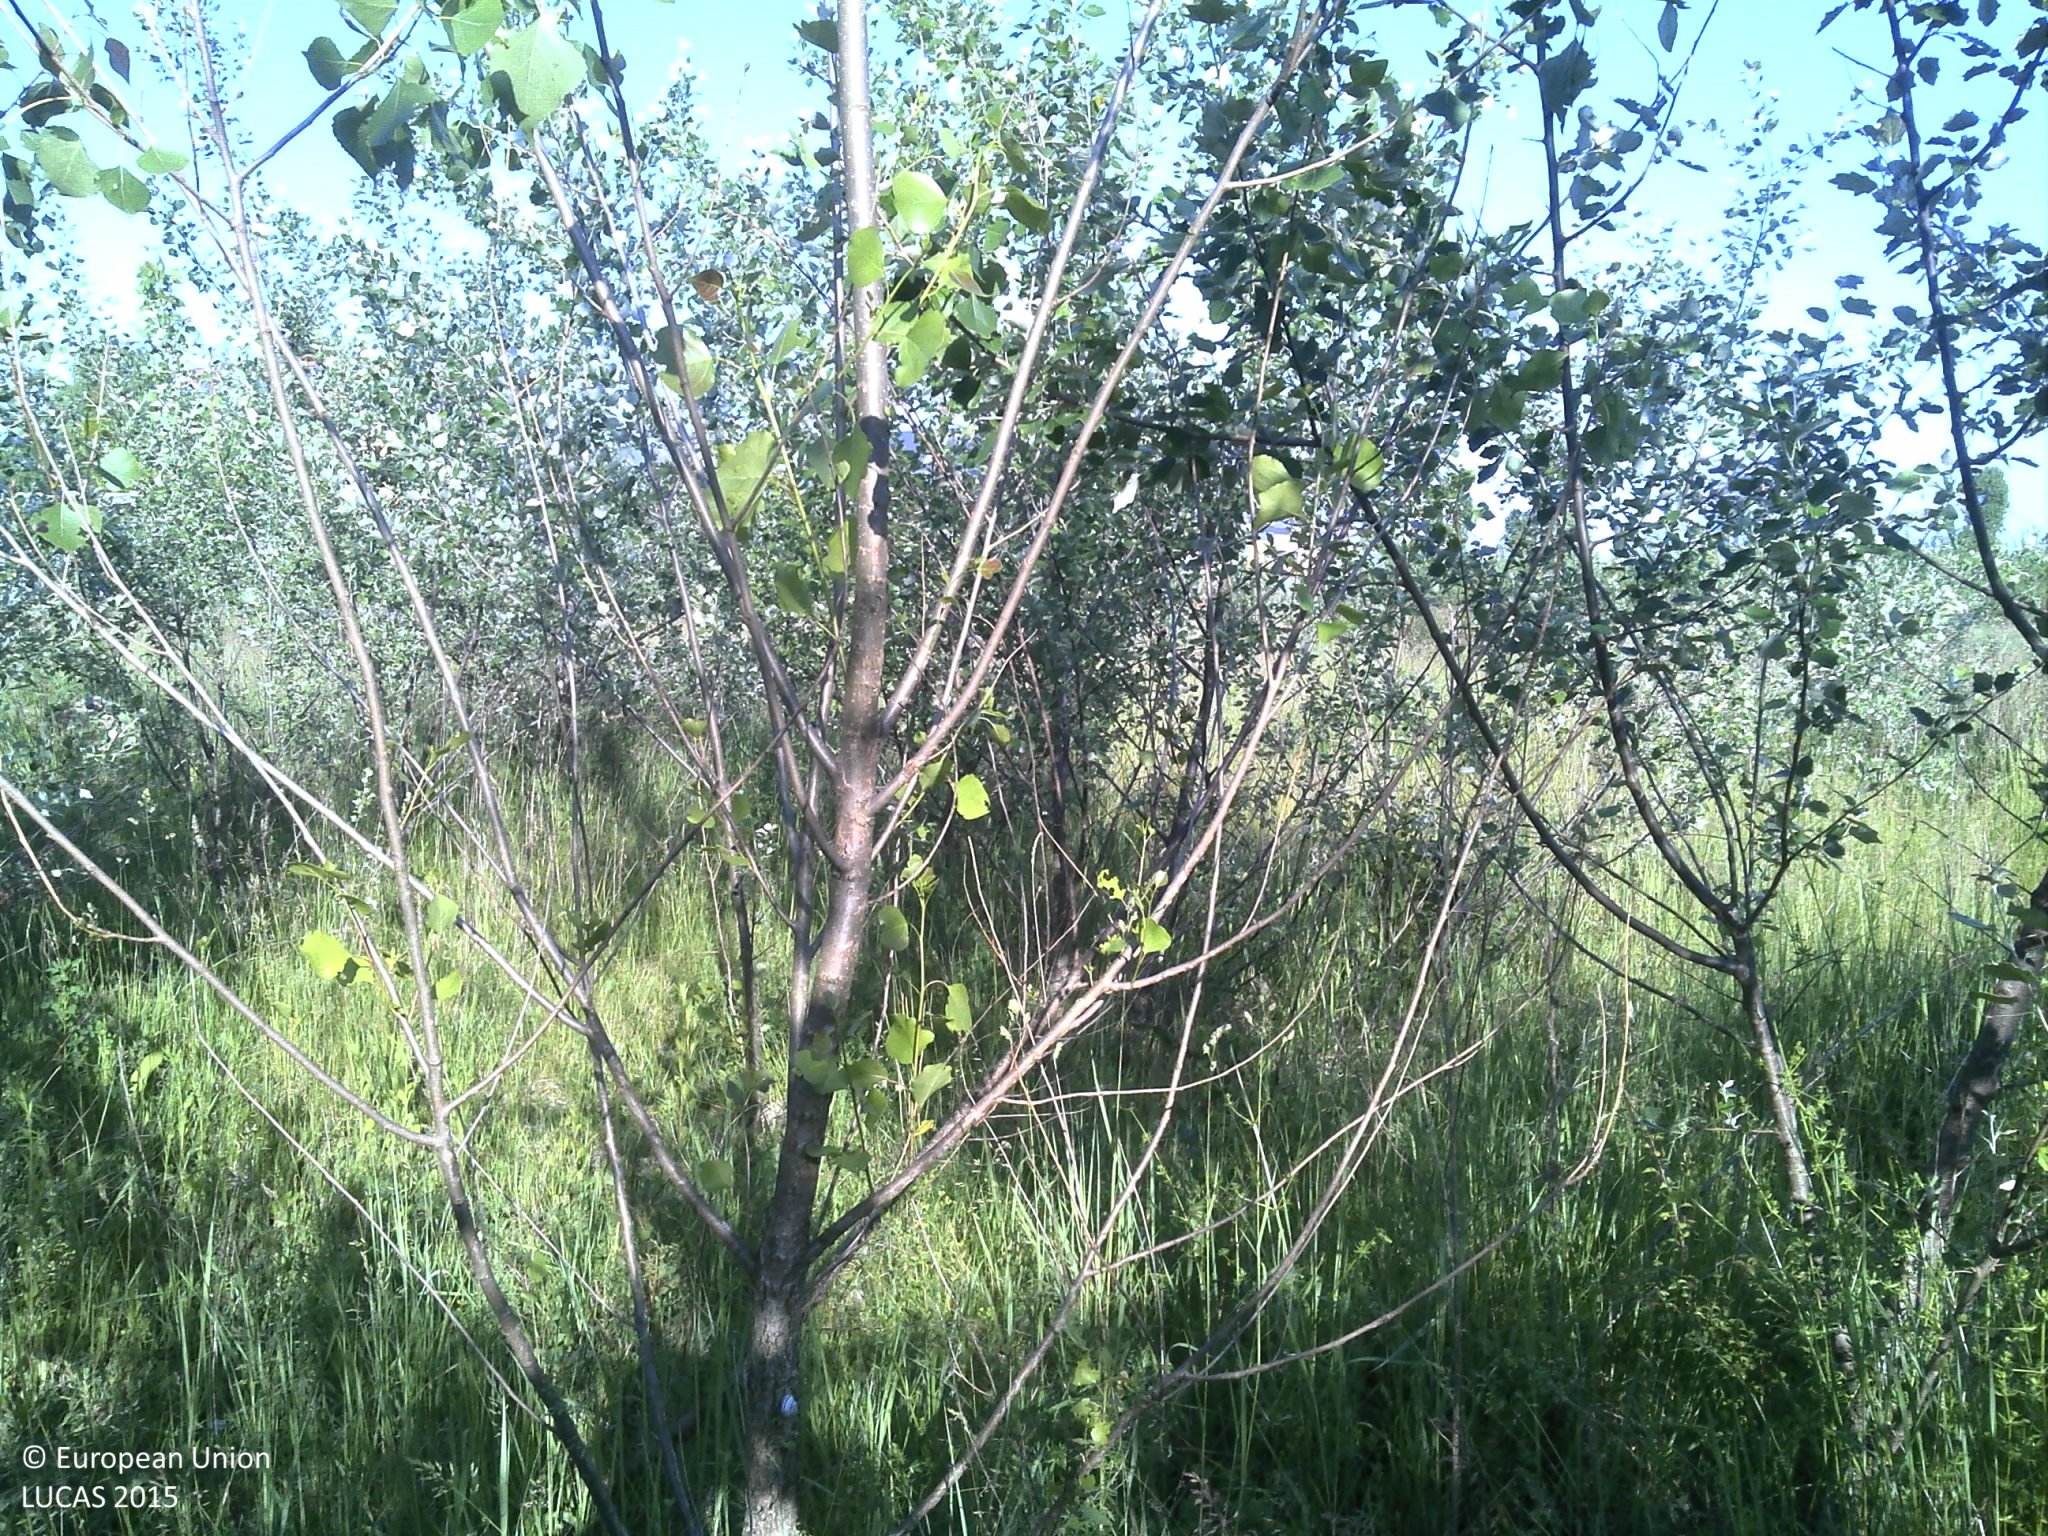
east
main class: Grassland
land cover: Grassland with sparse tree/shrub cover
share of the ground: > 75 %
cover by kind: herbaceous plants 85 %, shrubs 10 %, broadleaved forest trees 5 %
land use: Semi-natural and natural areas not in use
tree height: < 5 m
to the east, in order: Grassland with sparse tree/shrub cover; Artificial constructions in urban areas
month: May
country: HR
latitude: 45.5472
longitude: 18.6531
